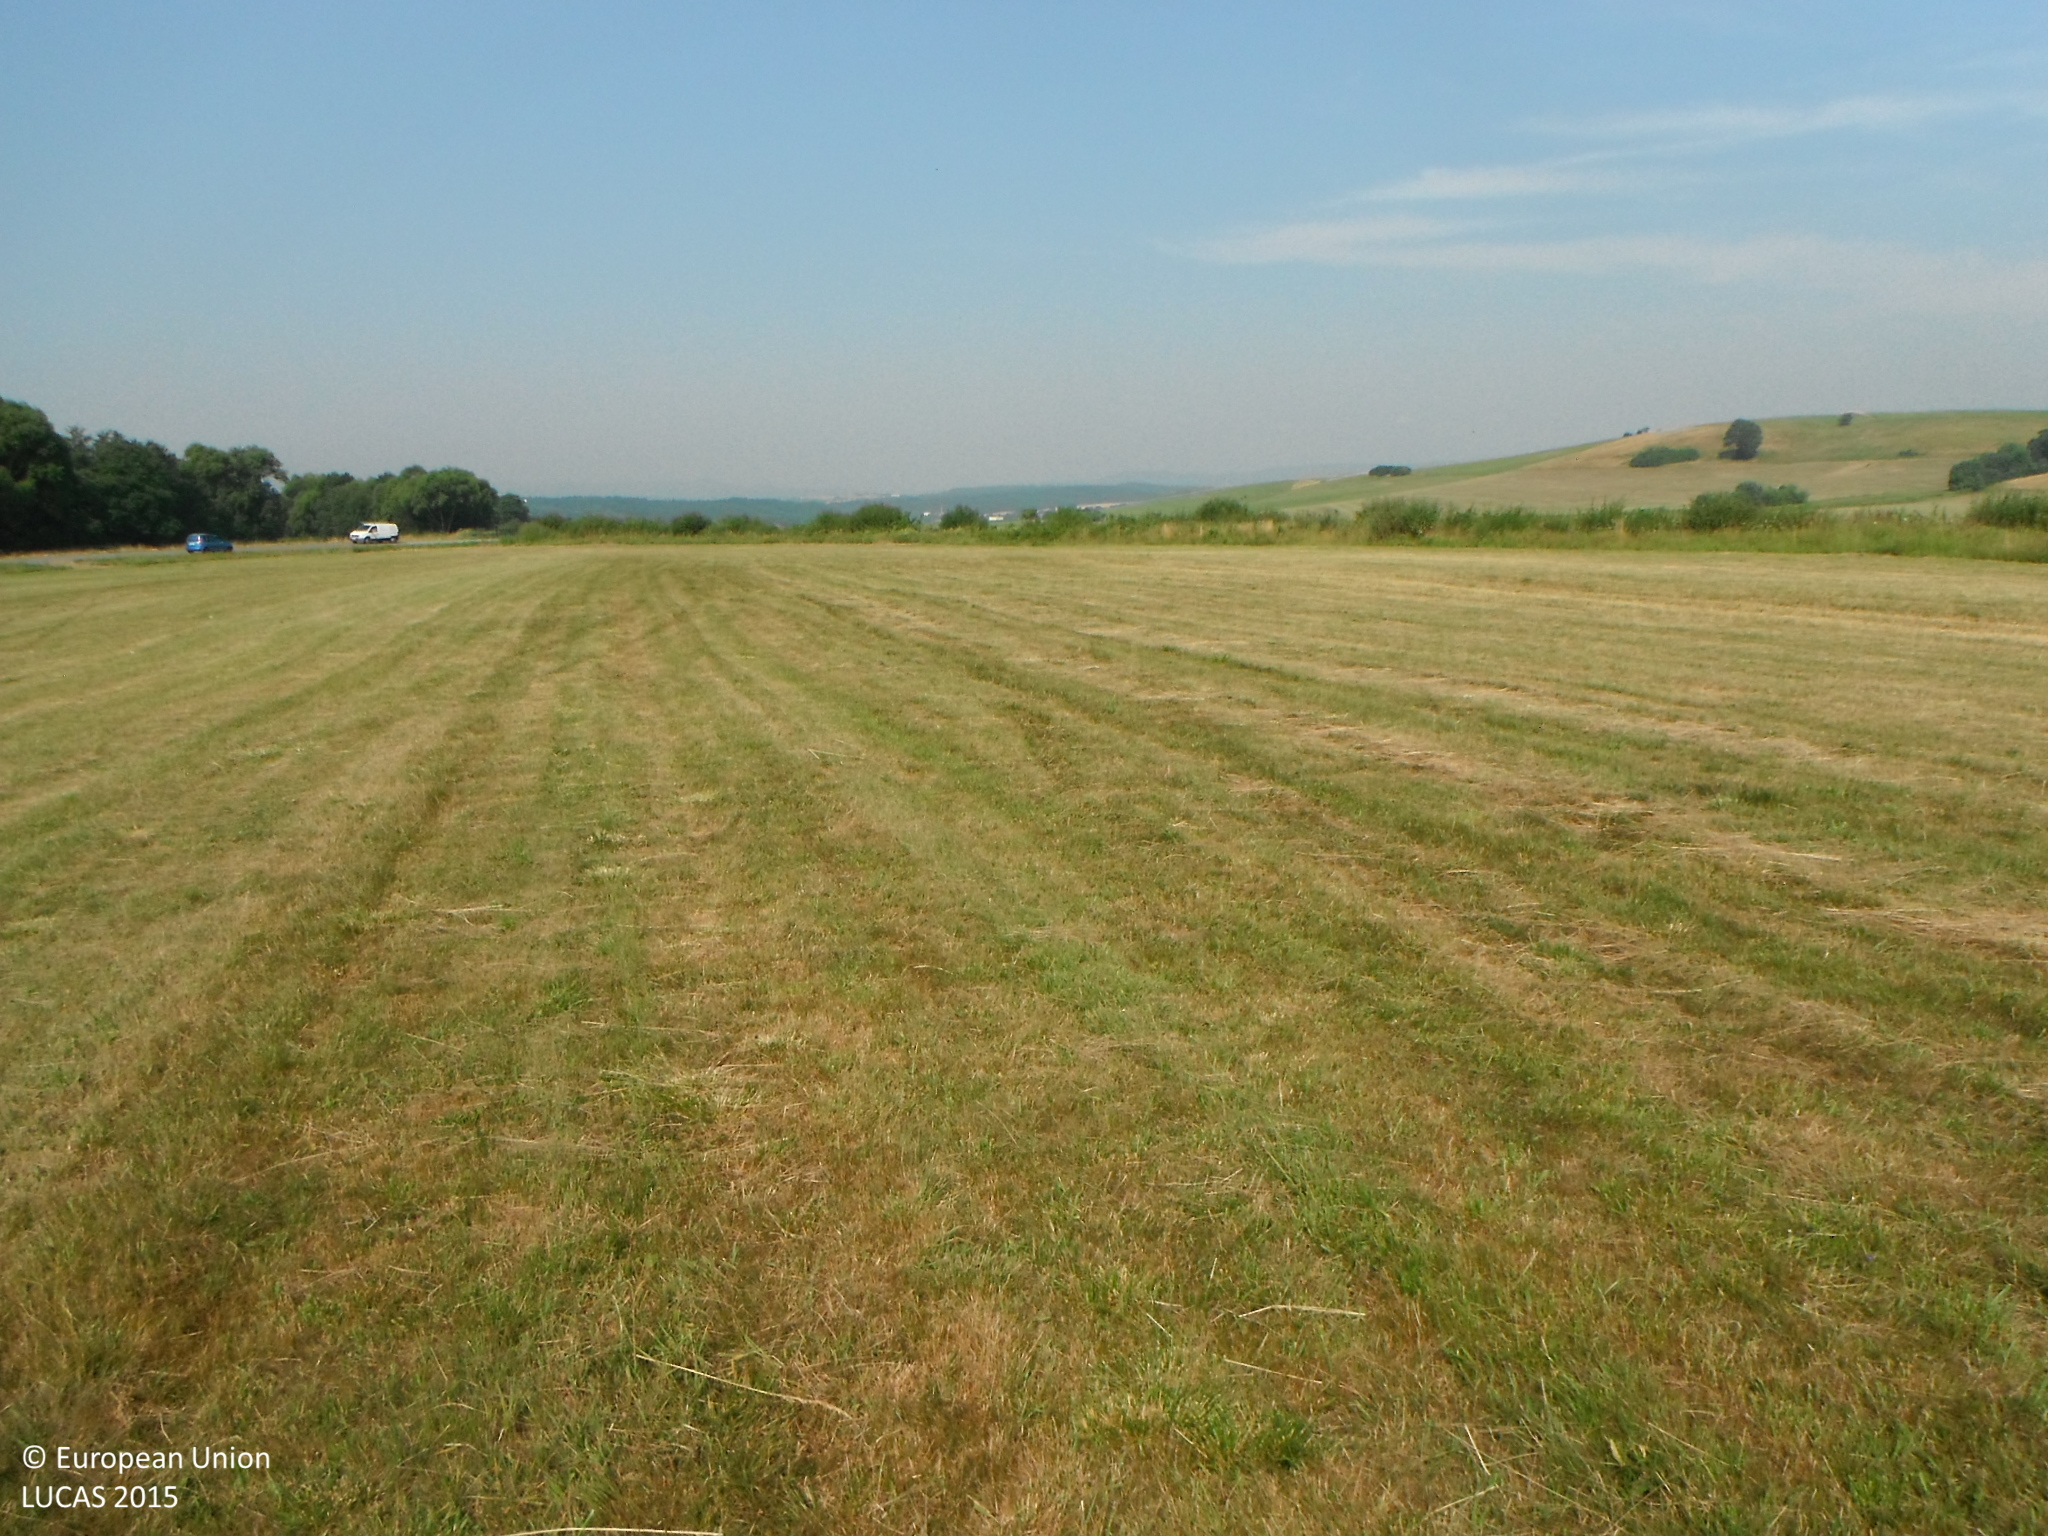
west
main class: Grassland
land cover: Grassland without tree/shrub cover
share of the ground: > 75 %
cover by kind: herbaceous plants 100 %
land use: Agriculture (excluding fallow land and kitchen gardens)
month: July
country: SK
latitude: 48.5940
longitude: 19.2565
